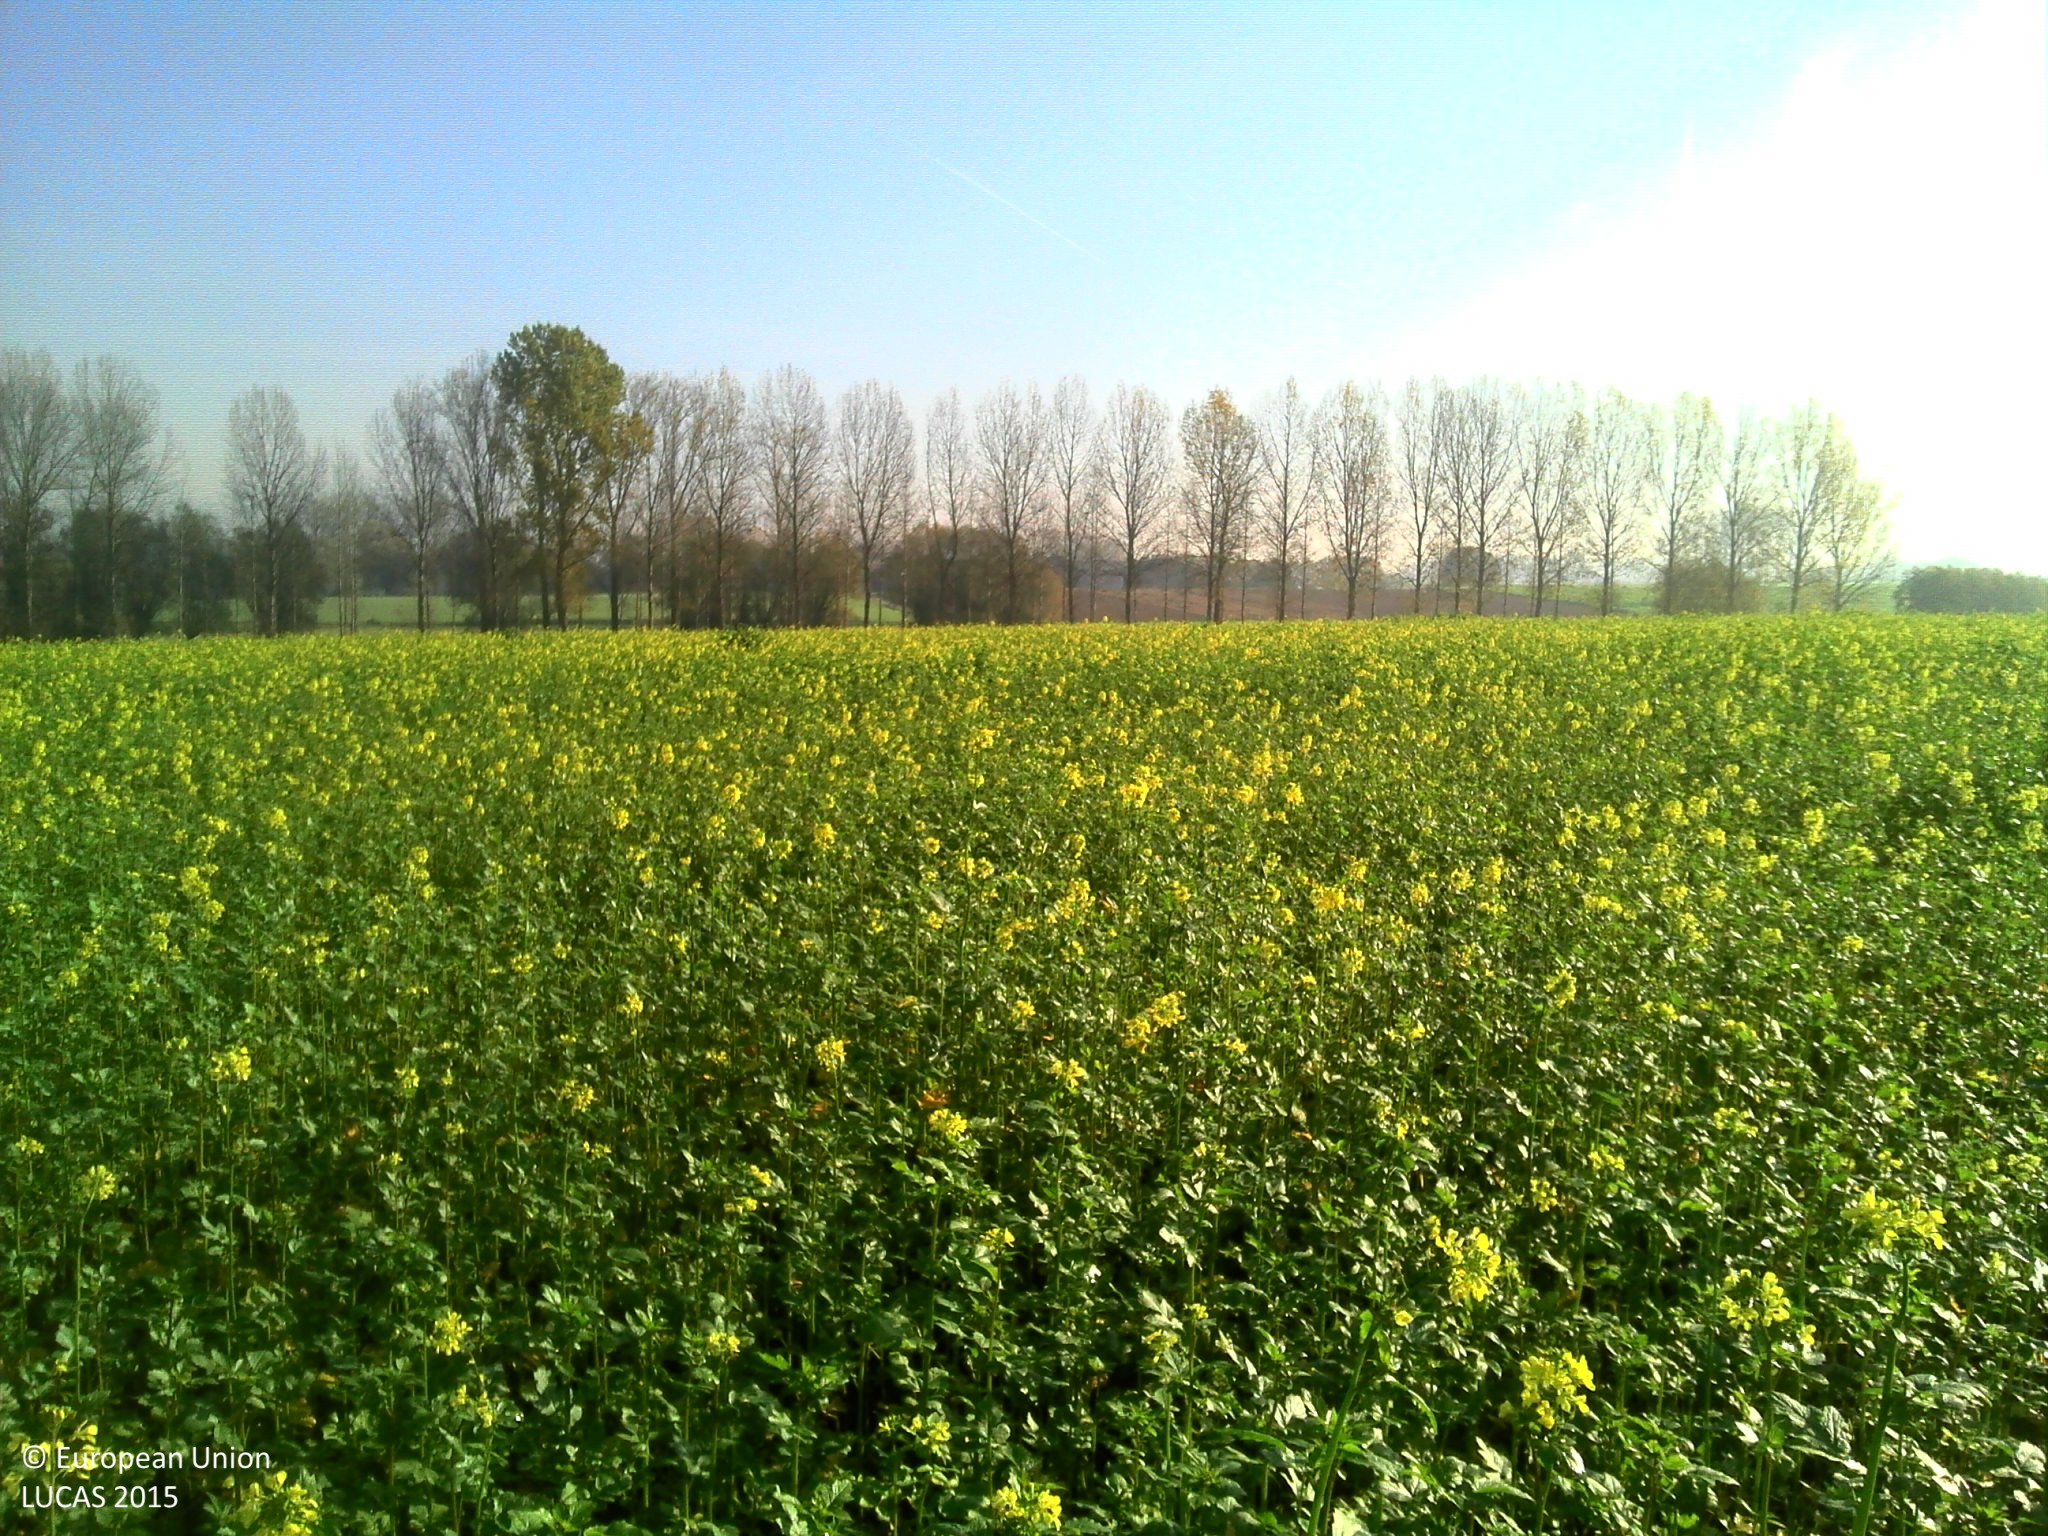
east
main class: Cropland
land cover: Other fibre and oleaginous crops
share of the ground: > 75 %
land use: Agriculture (excluding fallow land and kitchen gardens)
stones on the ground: < 10 %
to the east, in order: Other fibre and oleaginous crops; Common wheat; Fences; Grass margins; Lines of trees; Grassland with sparse tree/shrub cover
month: November
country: BE
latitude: 50.7504
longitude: 4.0556
